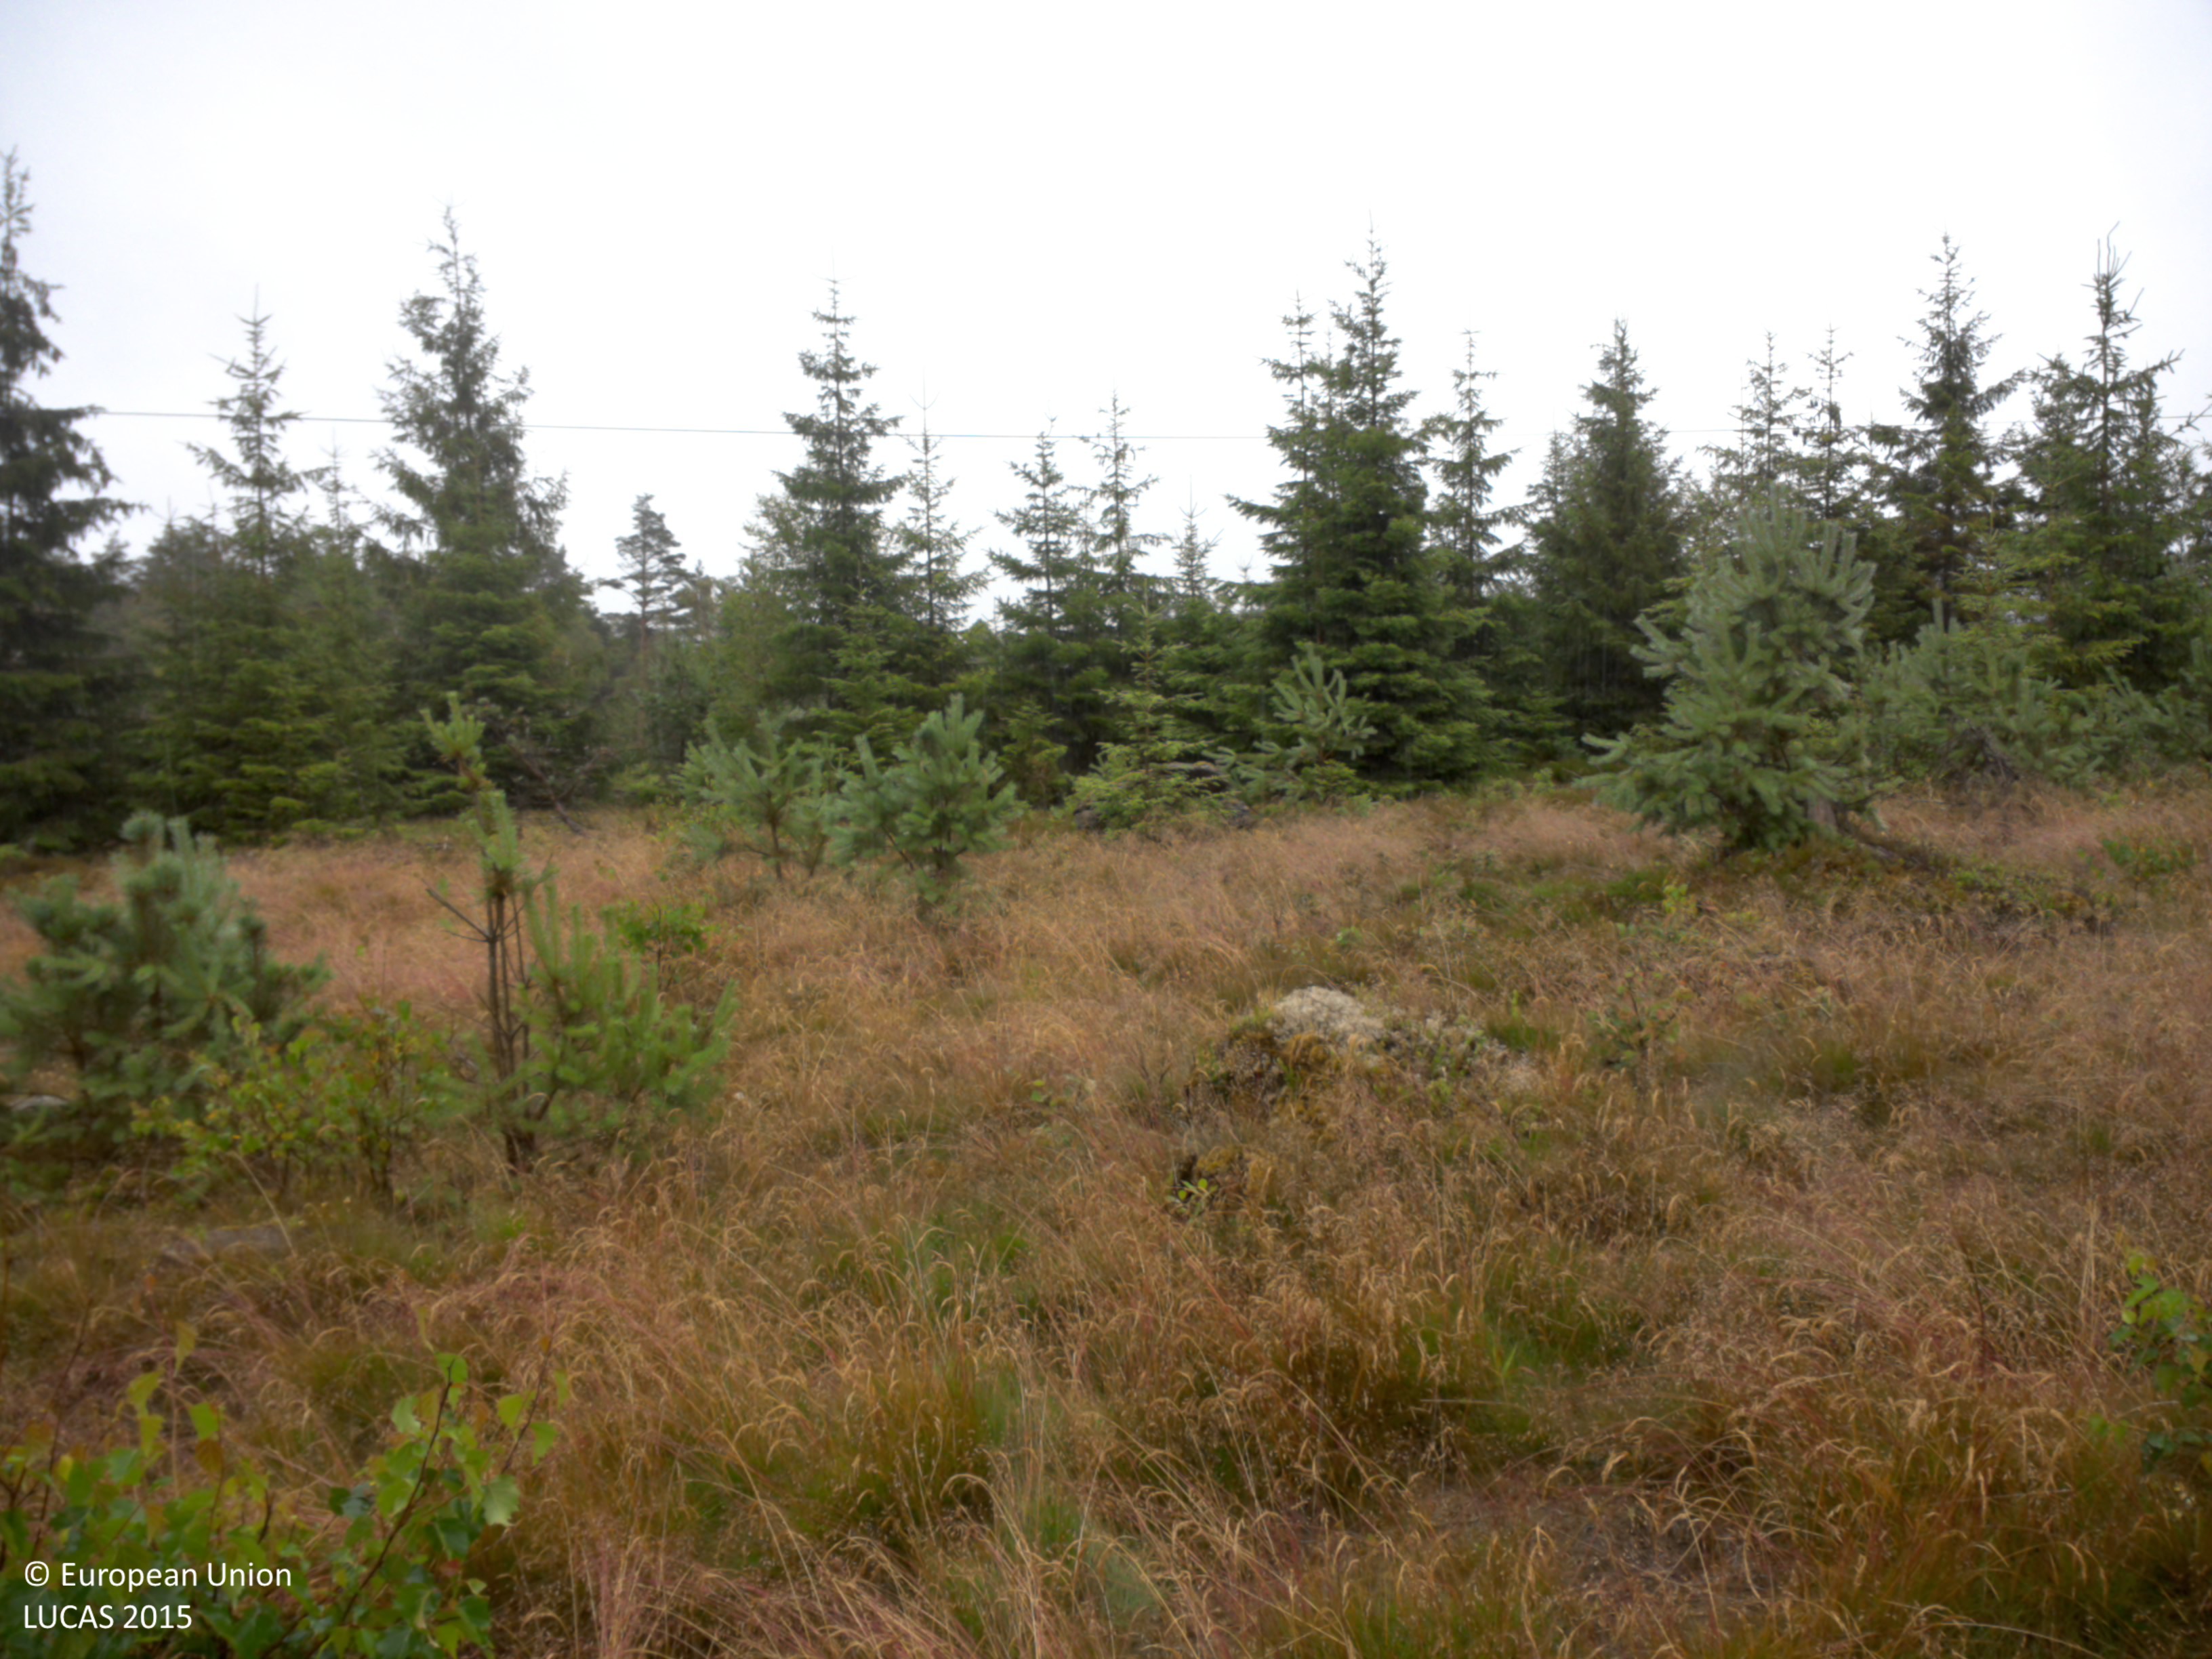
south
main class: Woodland
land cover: Pine dominated mixed woodland
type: boreal forest
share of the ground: 25 - 50 %
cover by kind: herbaceous plants 50 %, coniferous forest trees 30 %, broadleaved forest trees 20 %
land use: Forestry
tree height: < 5 m
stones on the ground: < 10 %
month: July
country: SE
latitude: 58.6773
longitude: 11.6348
